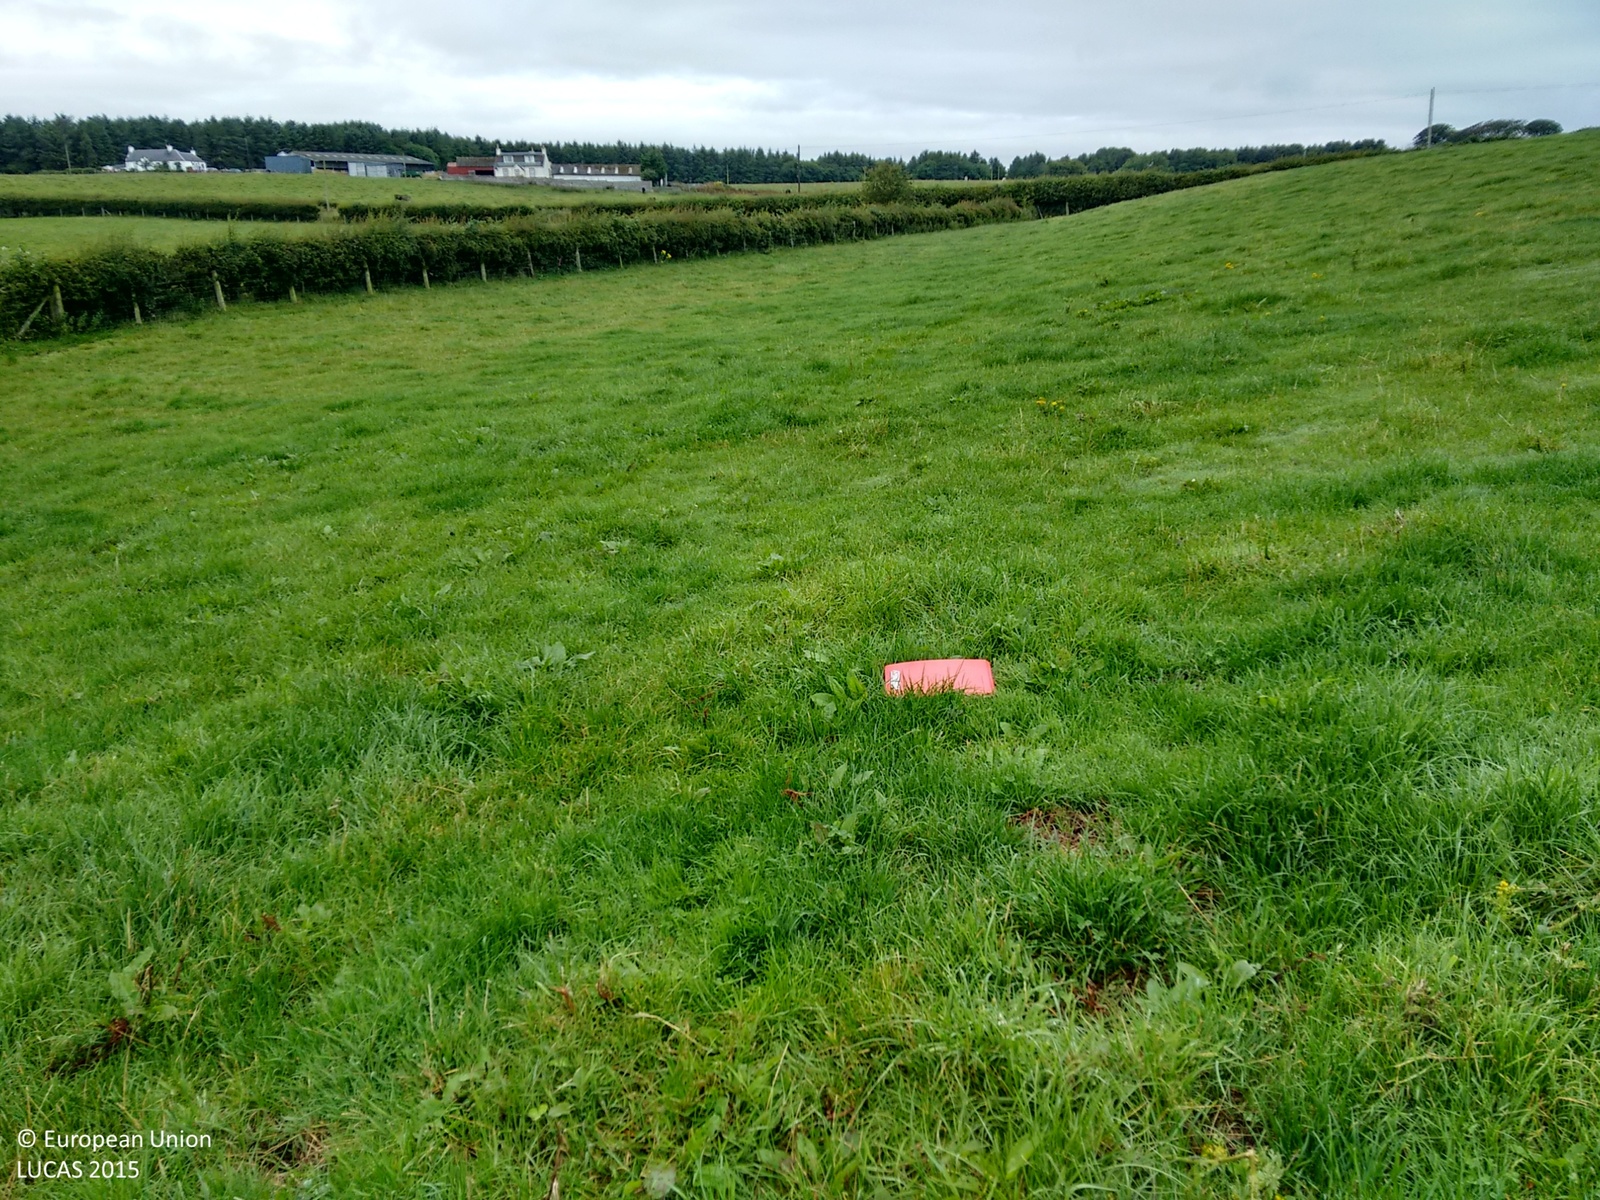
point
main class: Grassland
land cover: Grassland without tree/shrub cover
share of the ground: > 75 %
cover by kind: herbaceous plants 100 %
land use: Agriculture (excluding fallow land and kitchen gardens)
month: August
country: GB
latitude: 54.8813
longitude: -4.9674
